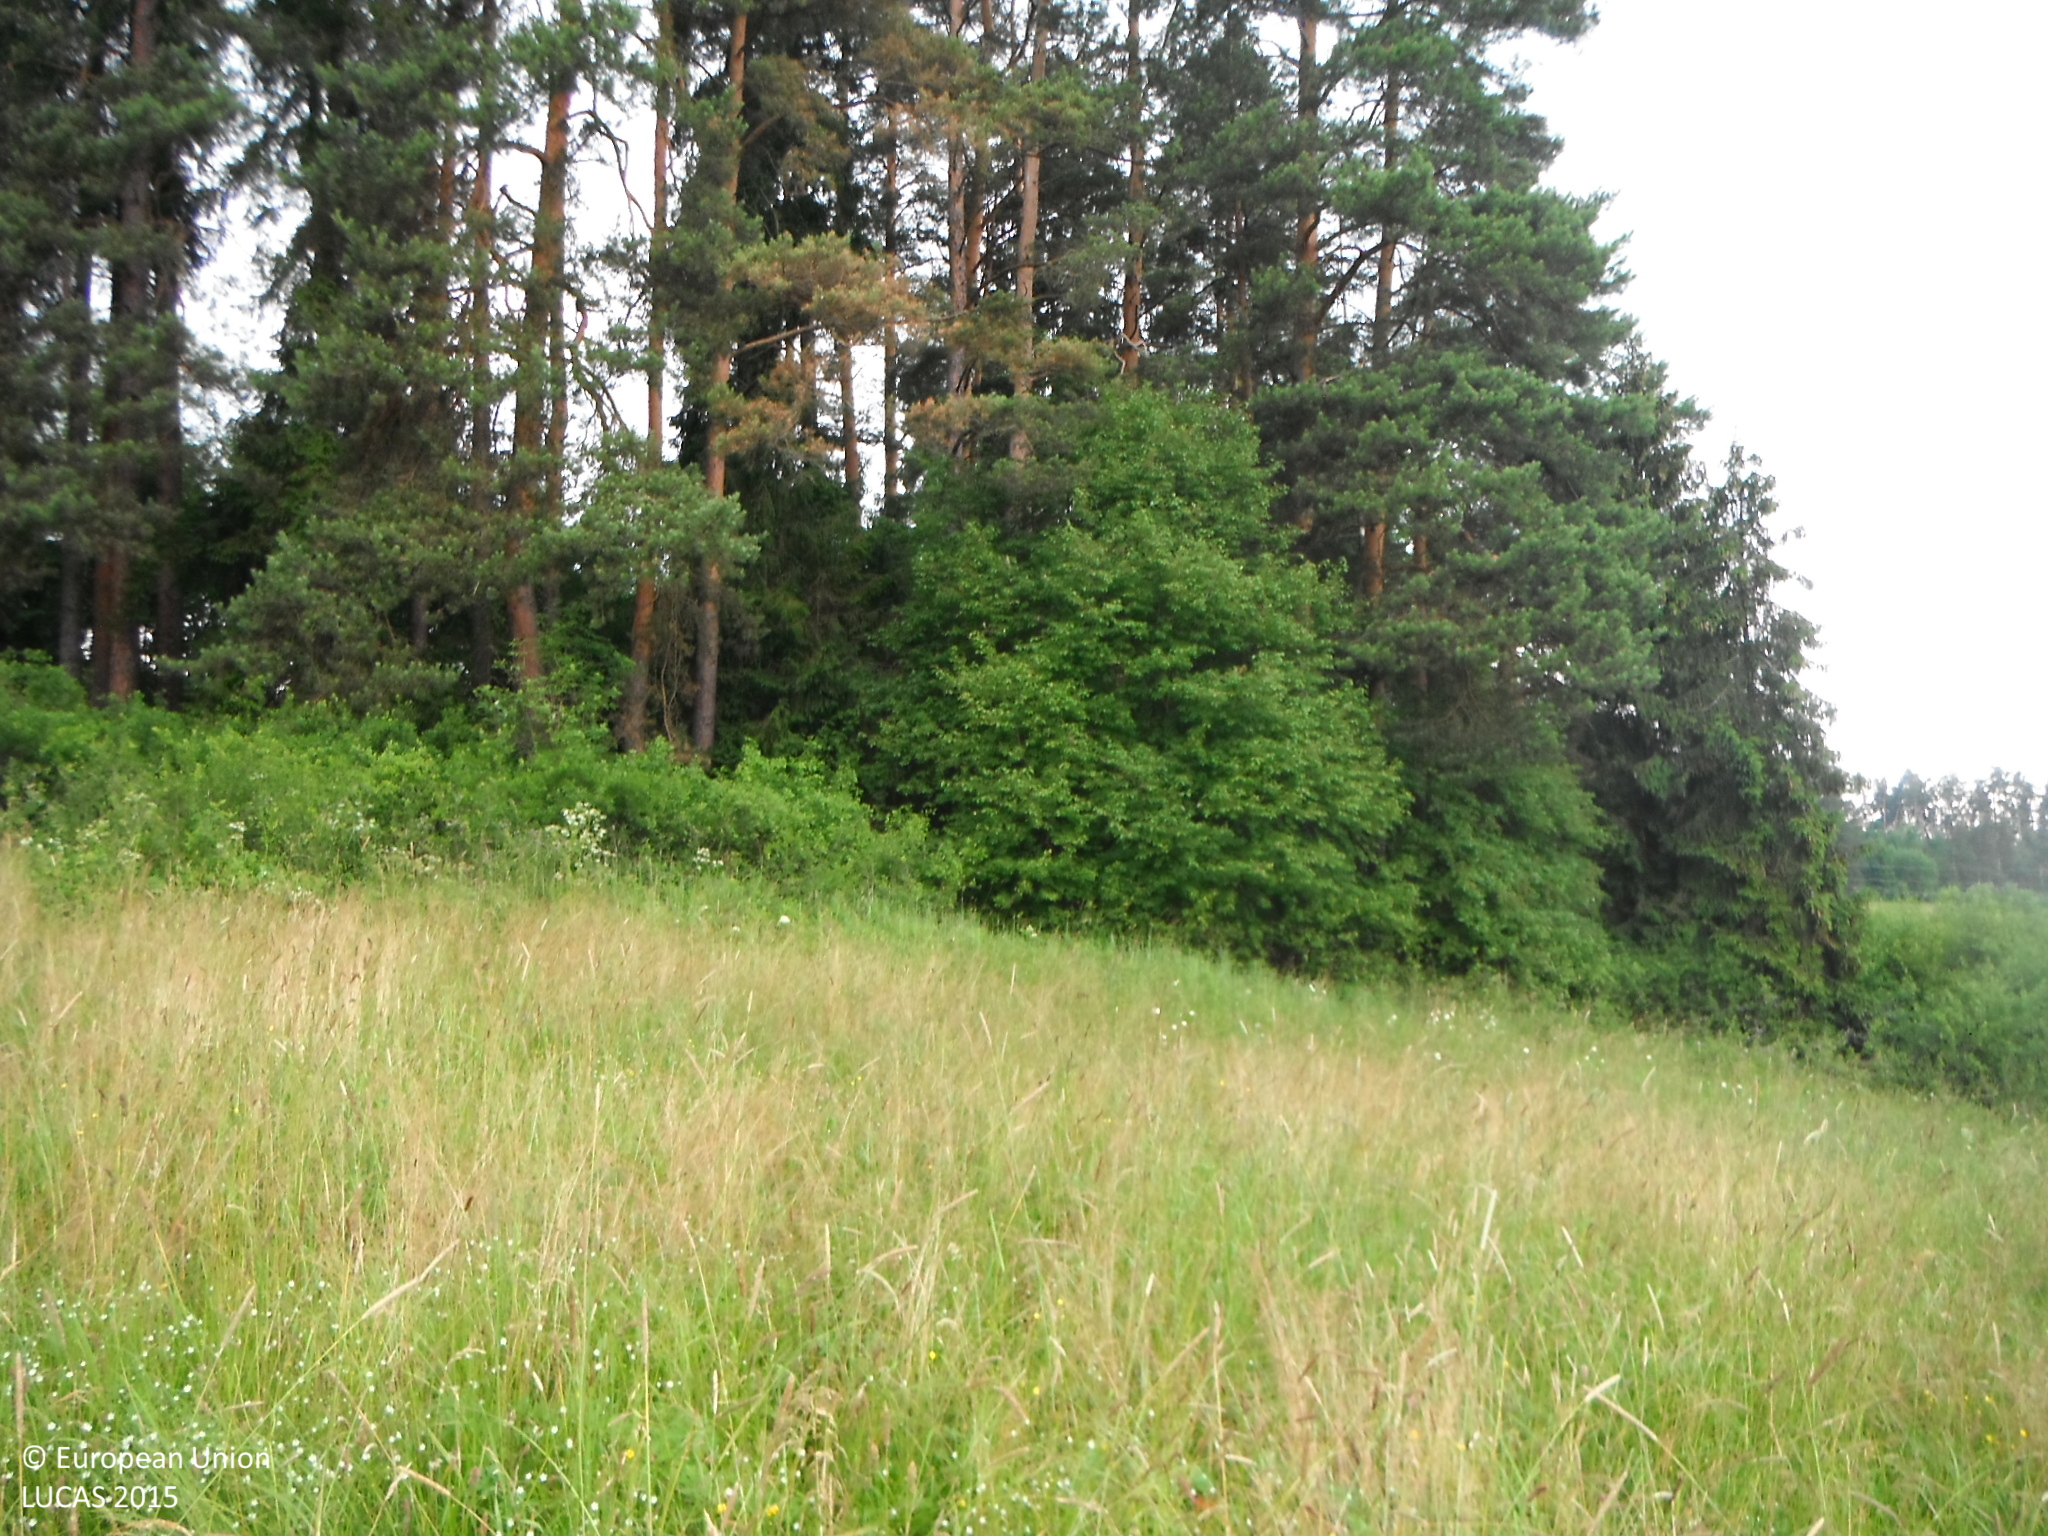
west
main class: Grassland
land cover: Grassland without tree/shrub cover
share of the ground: > 75 %
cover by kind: herbaceous plants 100 %
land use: Agriculture (excluding fallow land and kitchen gardens)
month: June
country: SK
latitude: 48.9660
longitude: 20.5683
